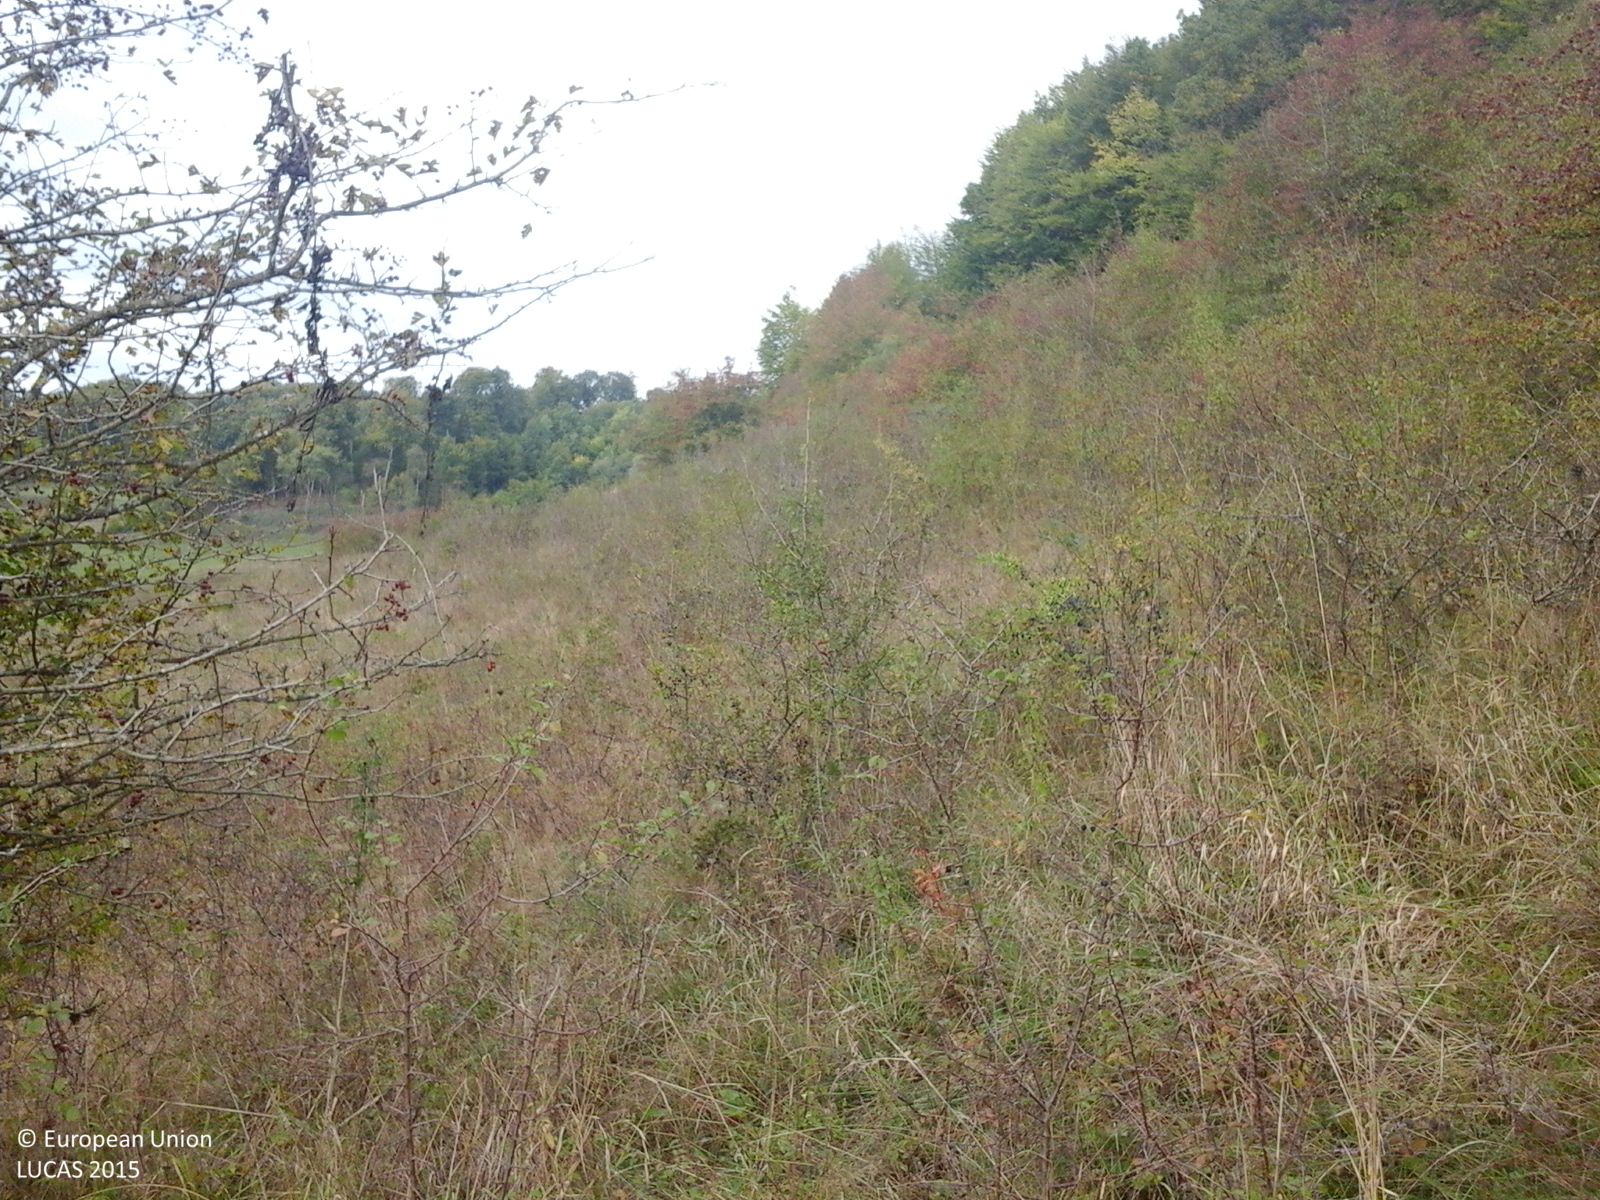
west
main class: Shrubland
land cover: Shrubland without tree cover
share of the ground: > 75 %
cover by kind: shrubs 100 %
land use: Semi-natural and natural areas not in use
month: October
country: RO
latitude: 46.4957
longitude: 24.9896
